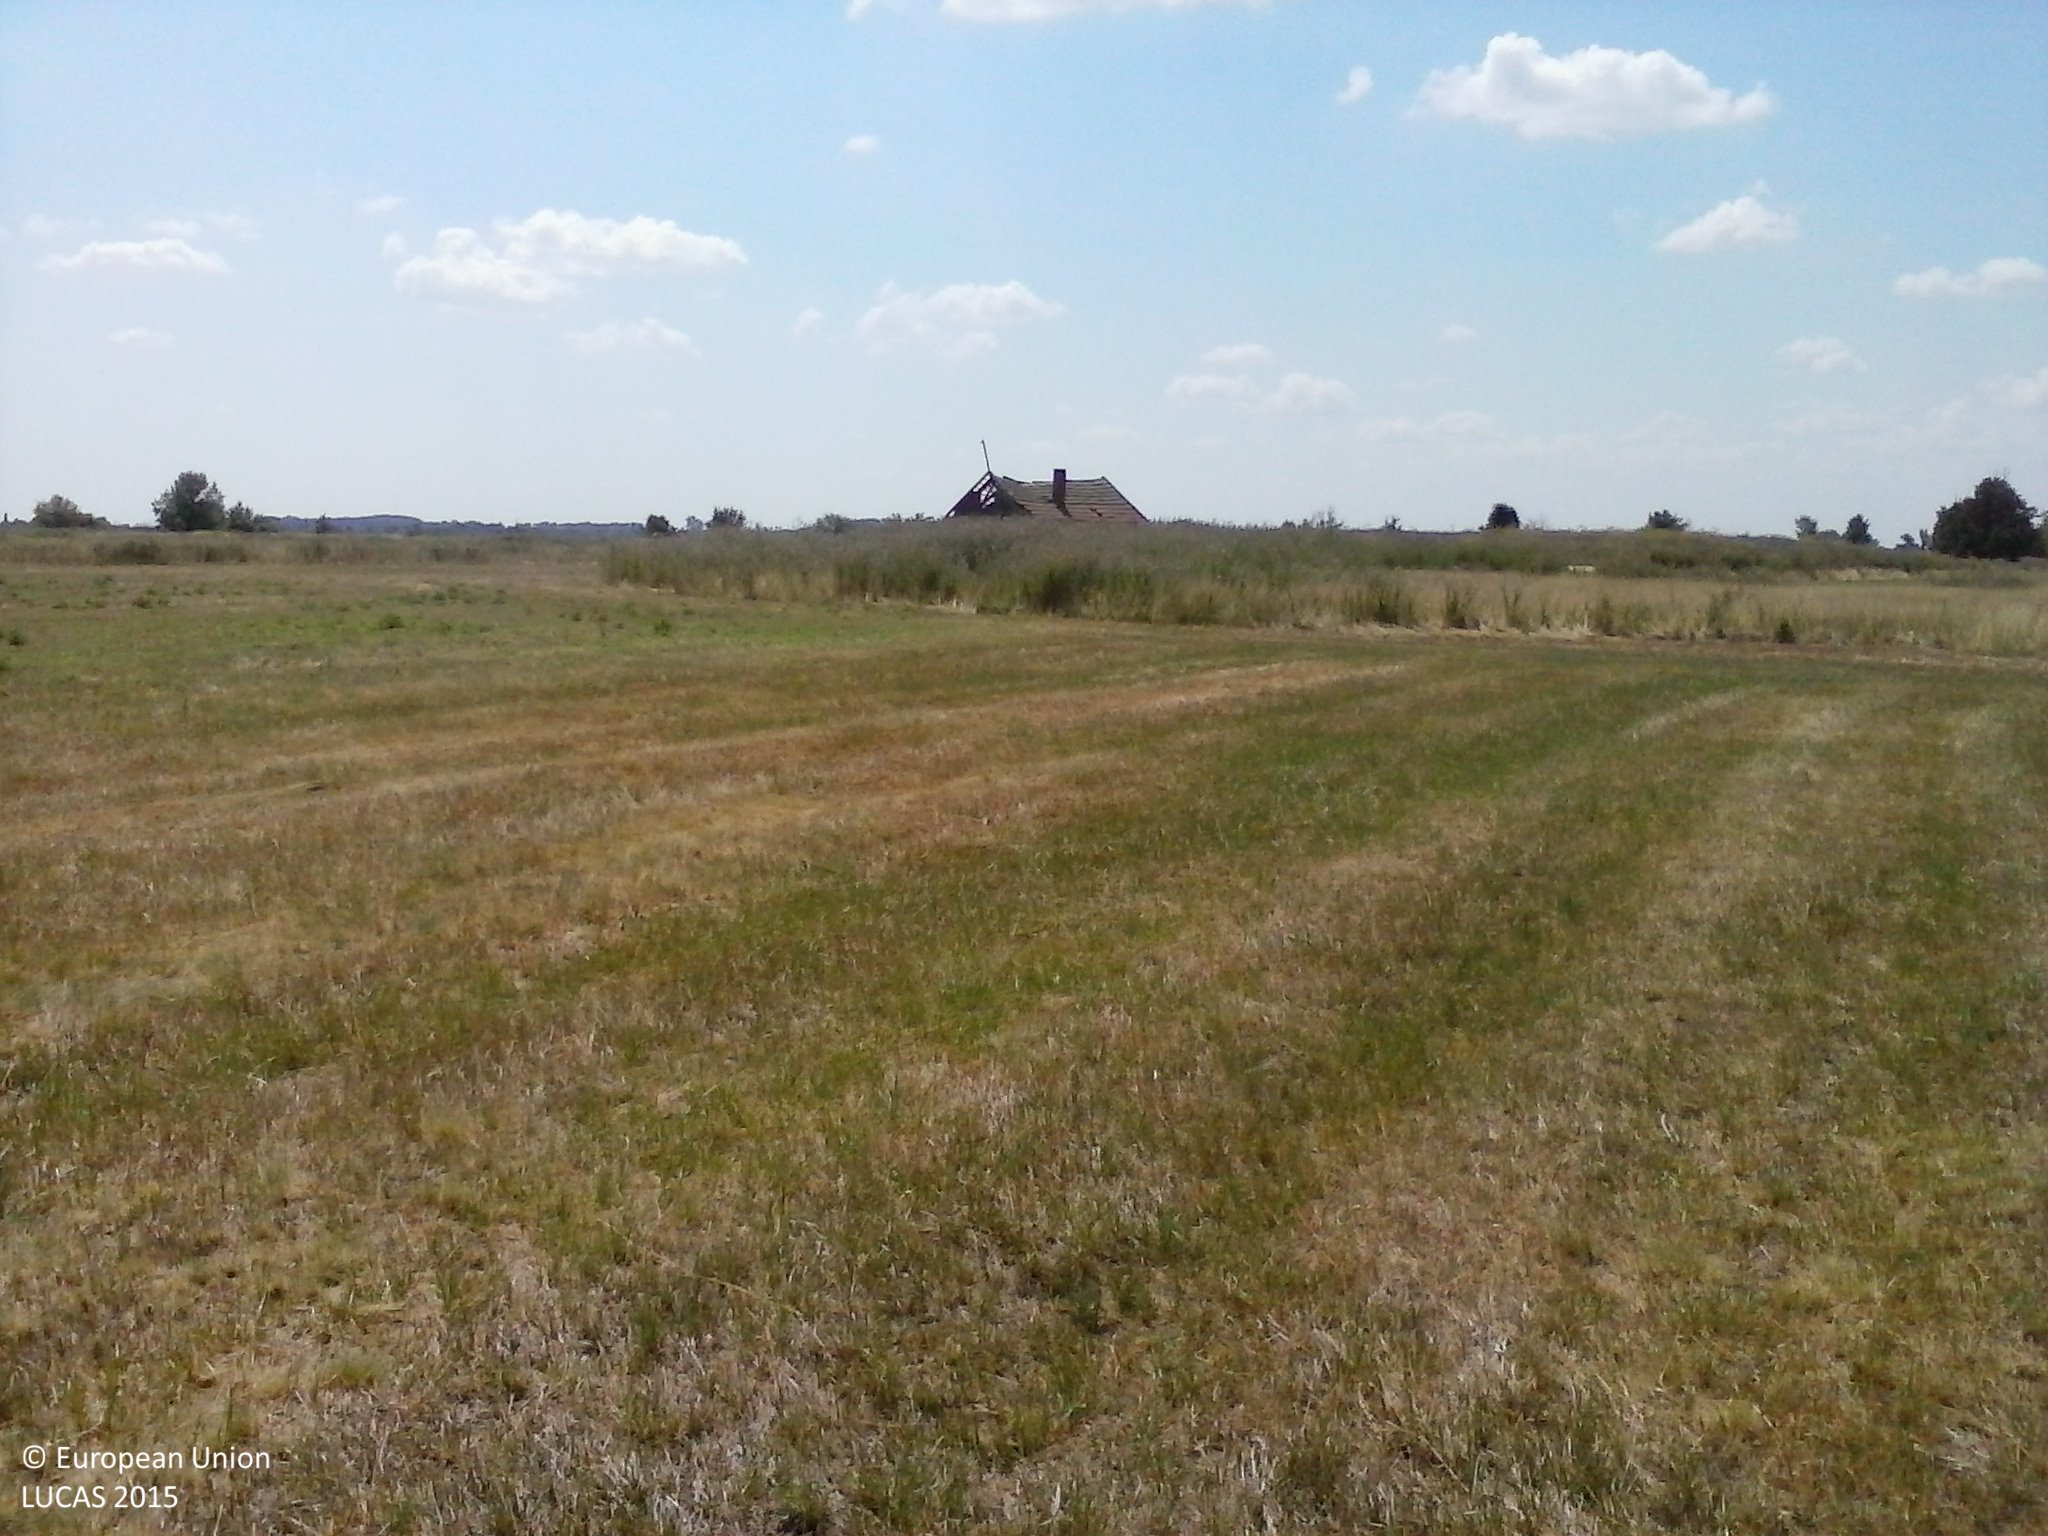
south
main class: Grassland
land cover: Grassland without tree/shrub cover
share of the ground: > 75 %
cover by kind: herbaceous plants 100 %
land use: Agriculture (excluding fallow land and kitchen gardens)
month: January
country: HU
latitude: 46.3757
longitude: 20.3338
